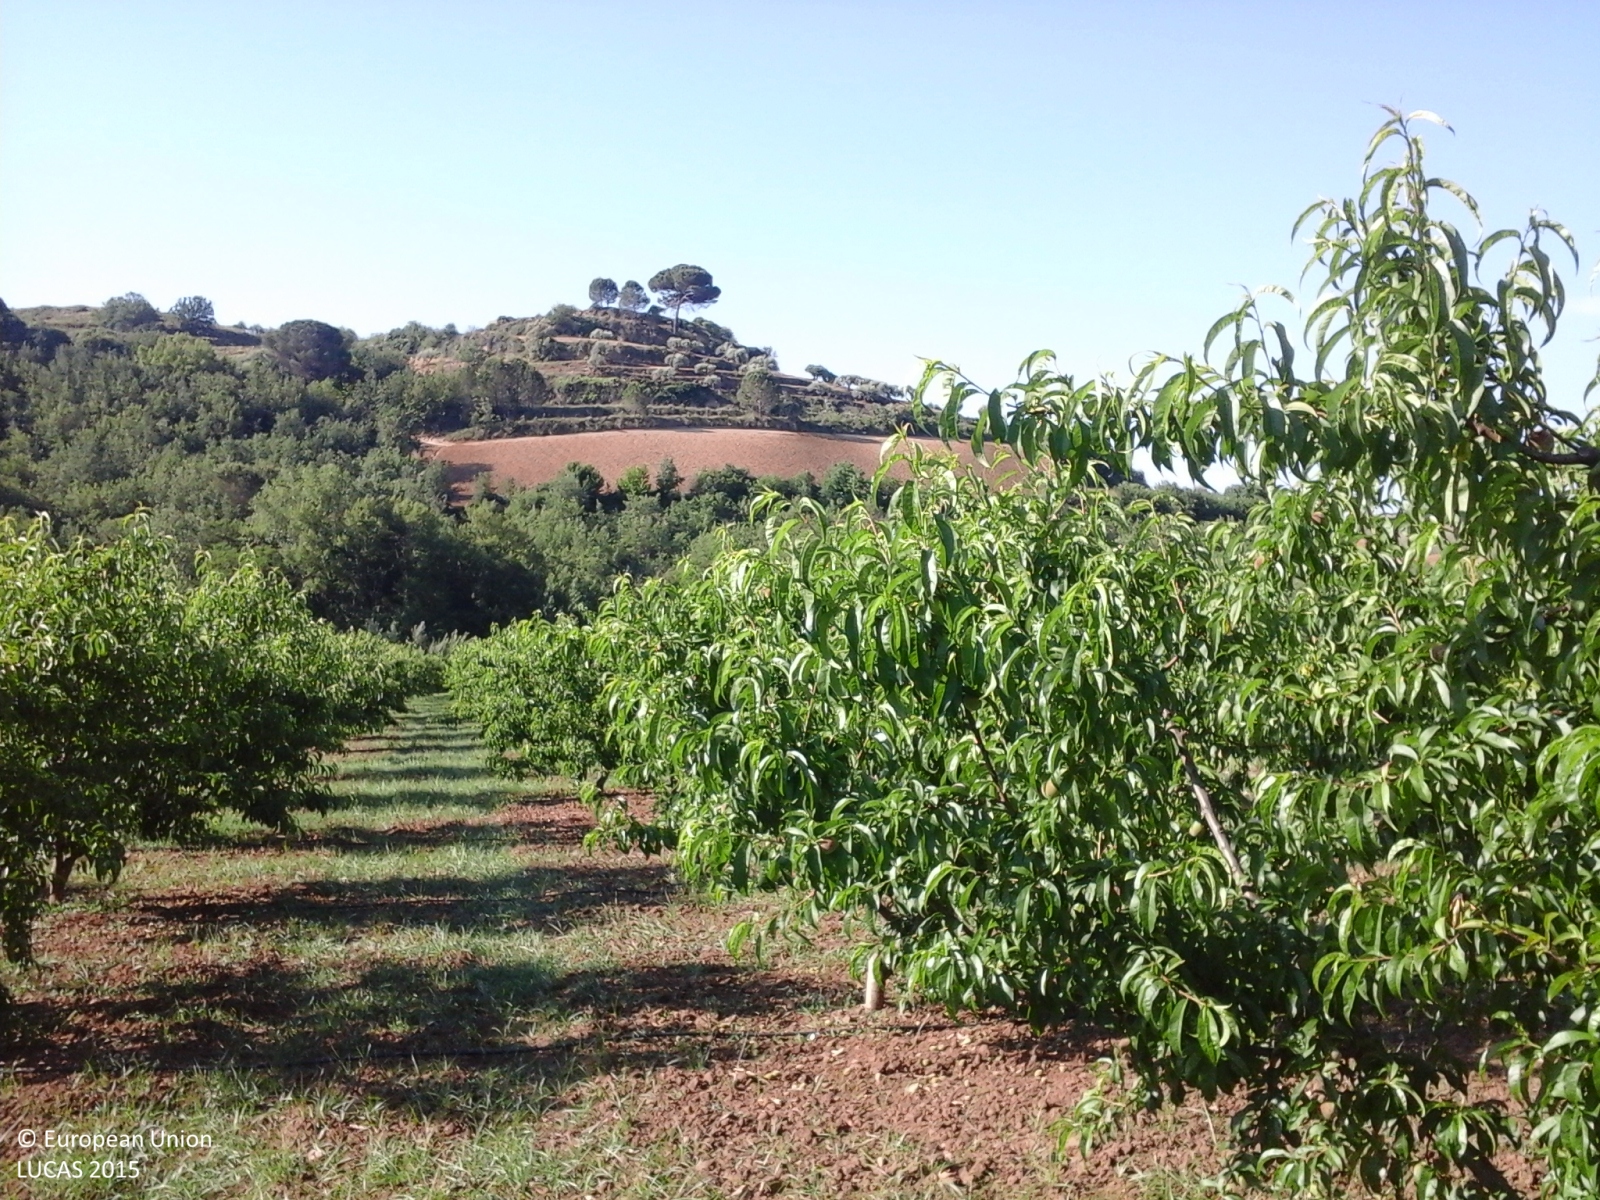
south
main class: Cropland
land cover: Other fruit trees and berries
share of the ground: 25 - 50 %
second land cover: Other bare soil
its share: > 75 %
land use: Agriculture (excluding fallow land and kitchen gardens)
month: June
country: IT
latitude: 37.3536
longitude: 14.4260
